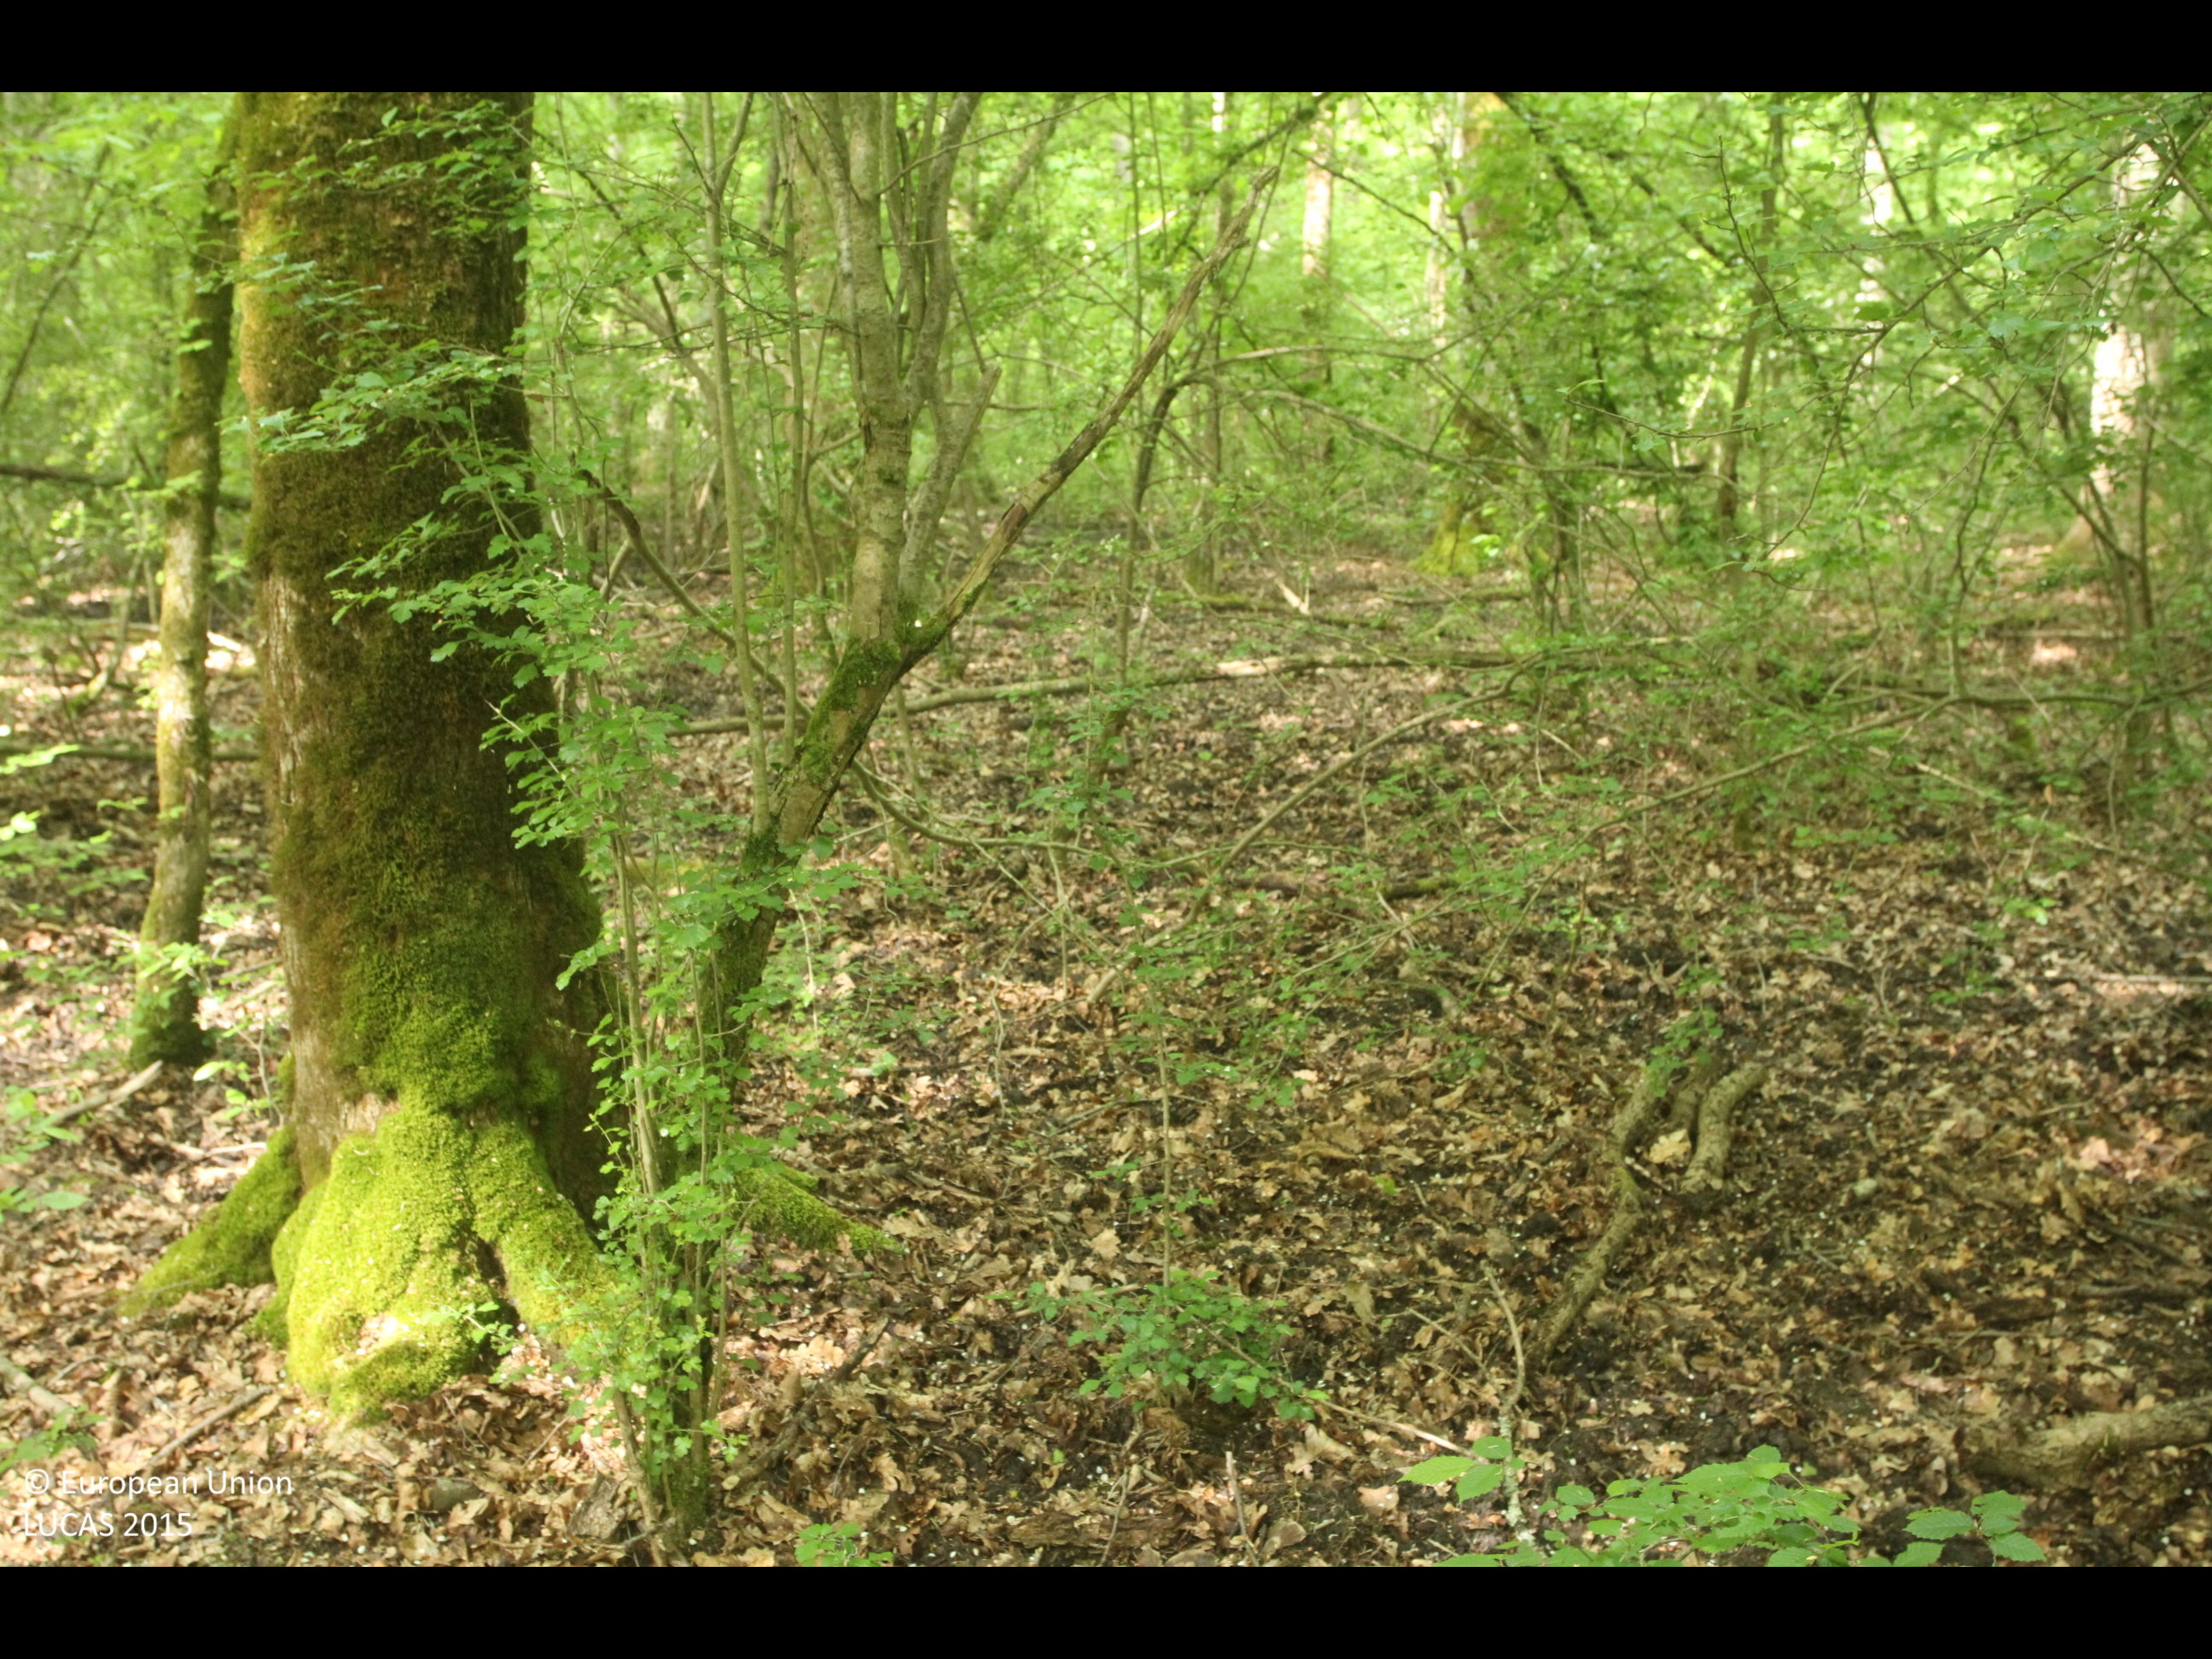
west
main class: Woodland
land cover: Broadleaved woodland
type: mesophytic deciduous forest
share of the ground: > 75 %
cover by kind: broadleaved forest trees 100 %
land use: Forestry
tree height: > 5 m
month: April
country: HR
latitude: 45.0260
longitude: 19.0312
